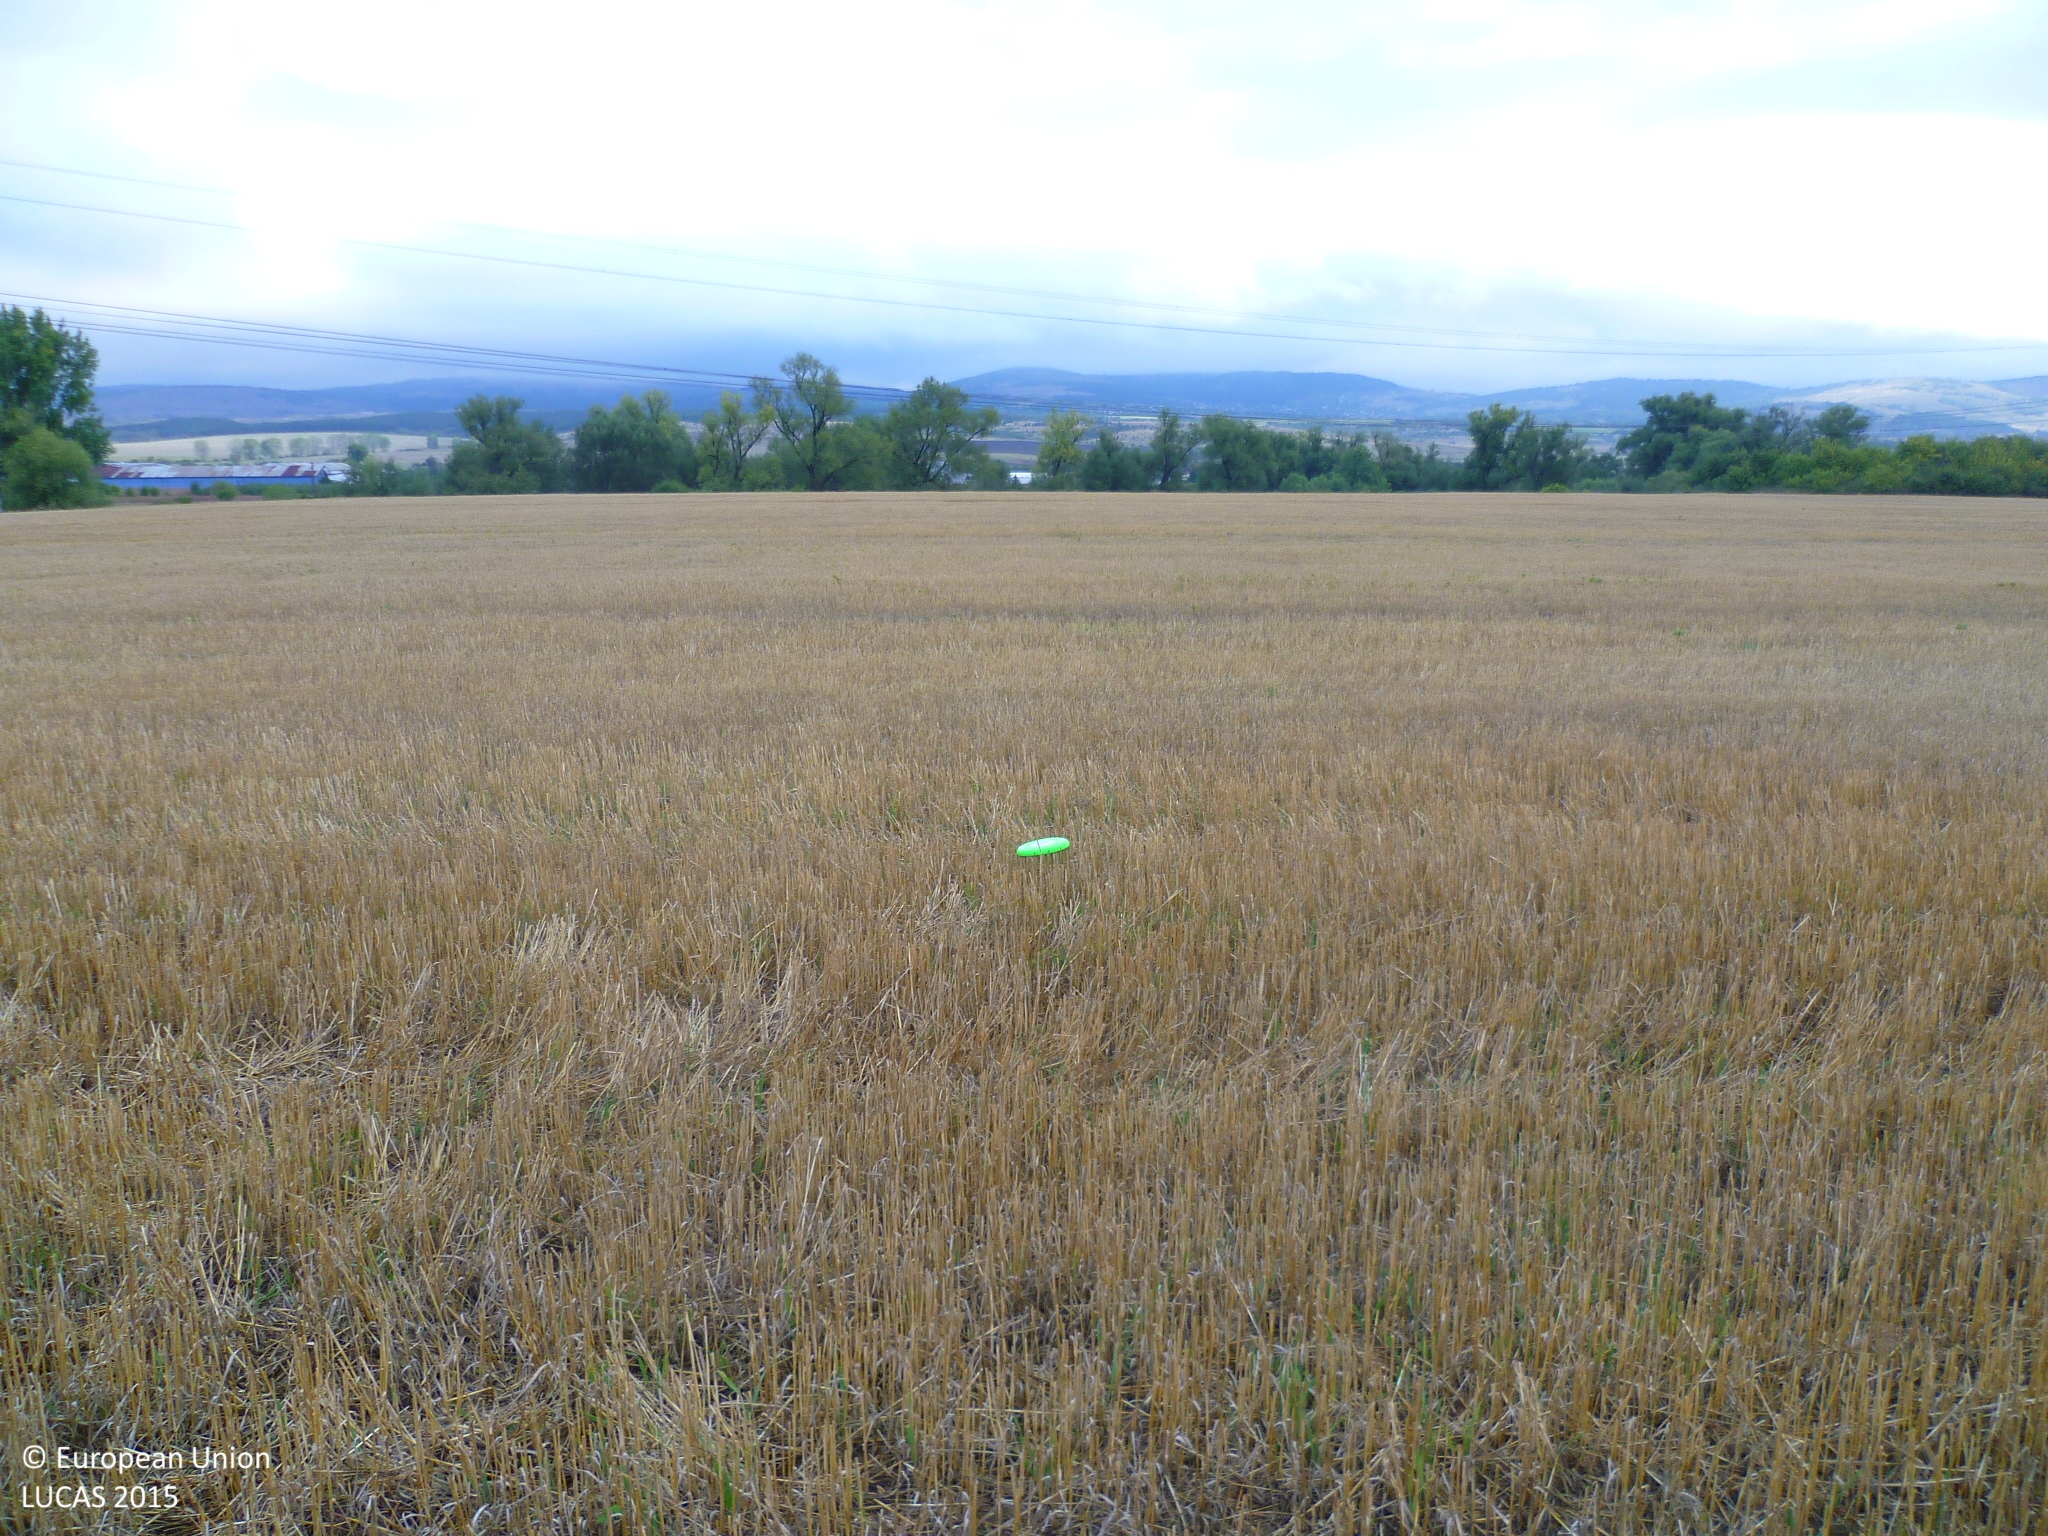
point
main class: Cropland
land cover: Rye
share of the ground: > 75 %
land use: Agriculture (excluding fallow land and kitchen gardens)
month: September
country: BG
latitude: 42.8327
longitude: 23.1599
